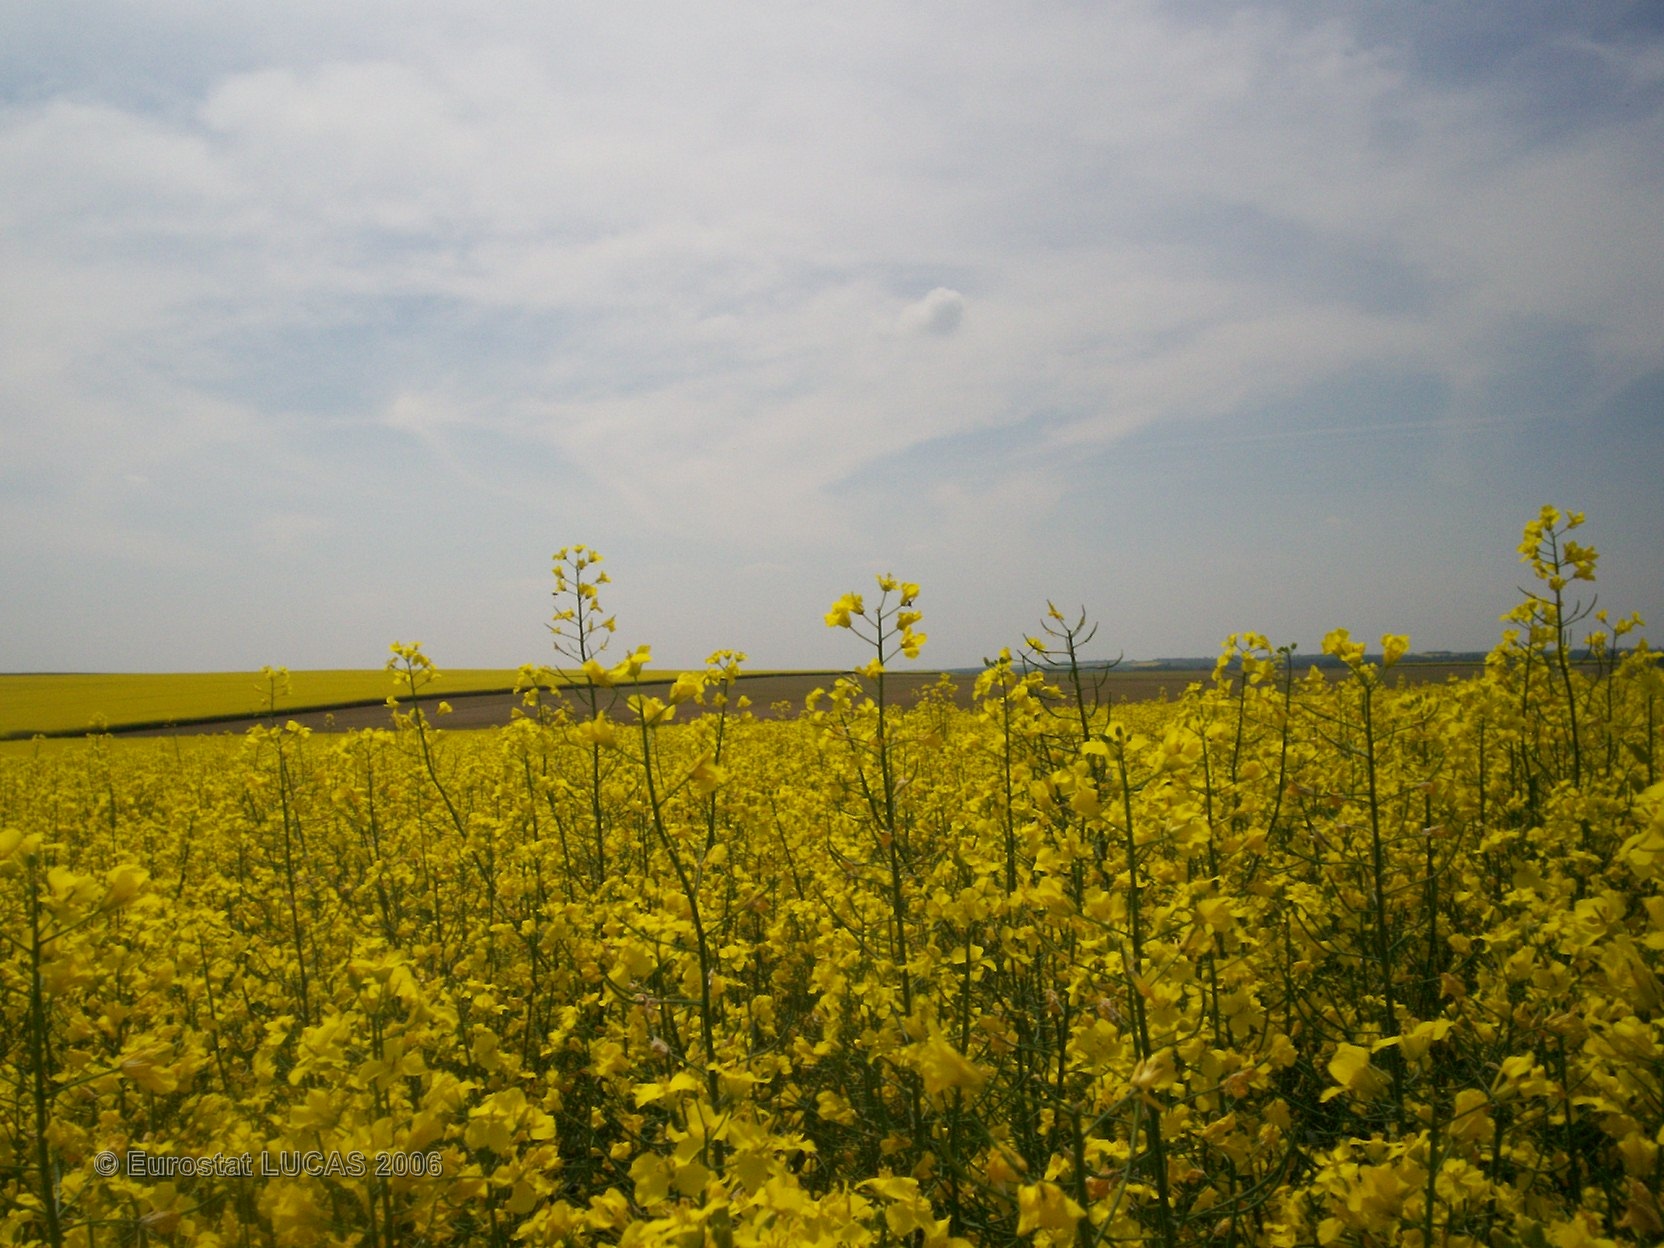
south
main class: Cropland
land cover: Rape and turnip rape
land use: Agriculture (excluding fallow land and kitchen gardens)
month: May
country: FR
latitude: 48.9309
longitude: 4.4410
